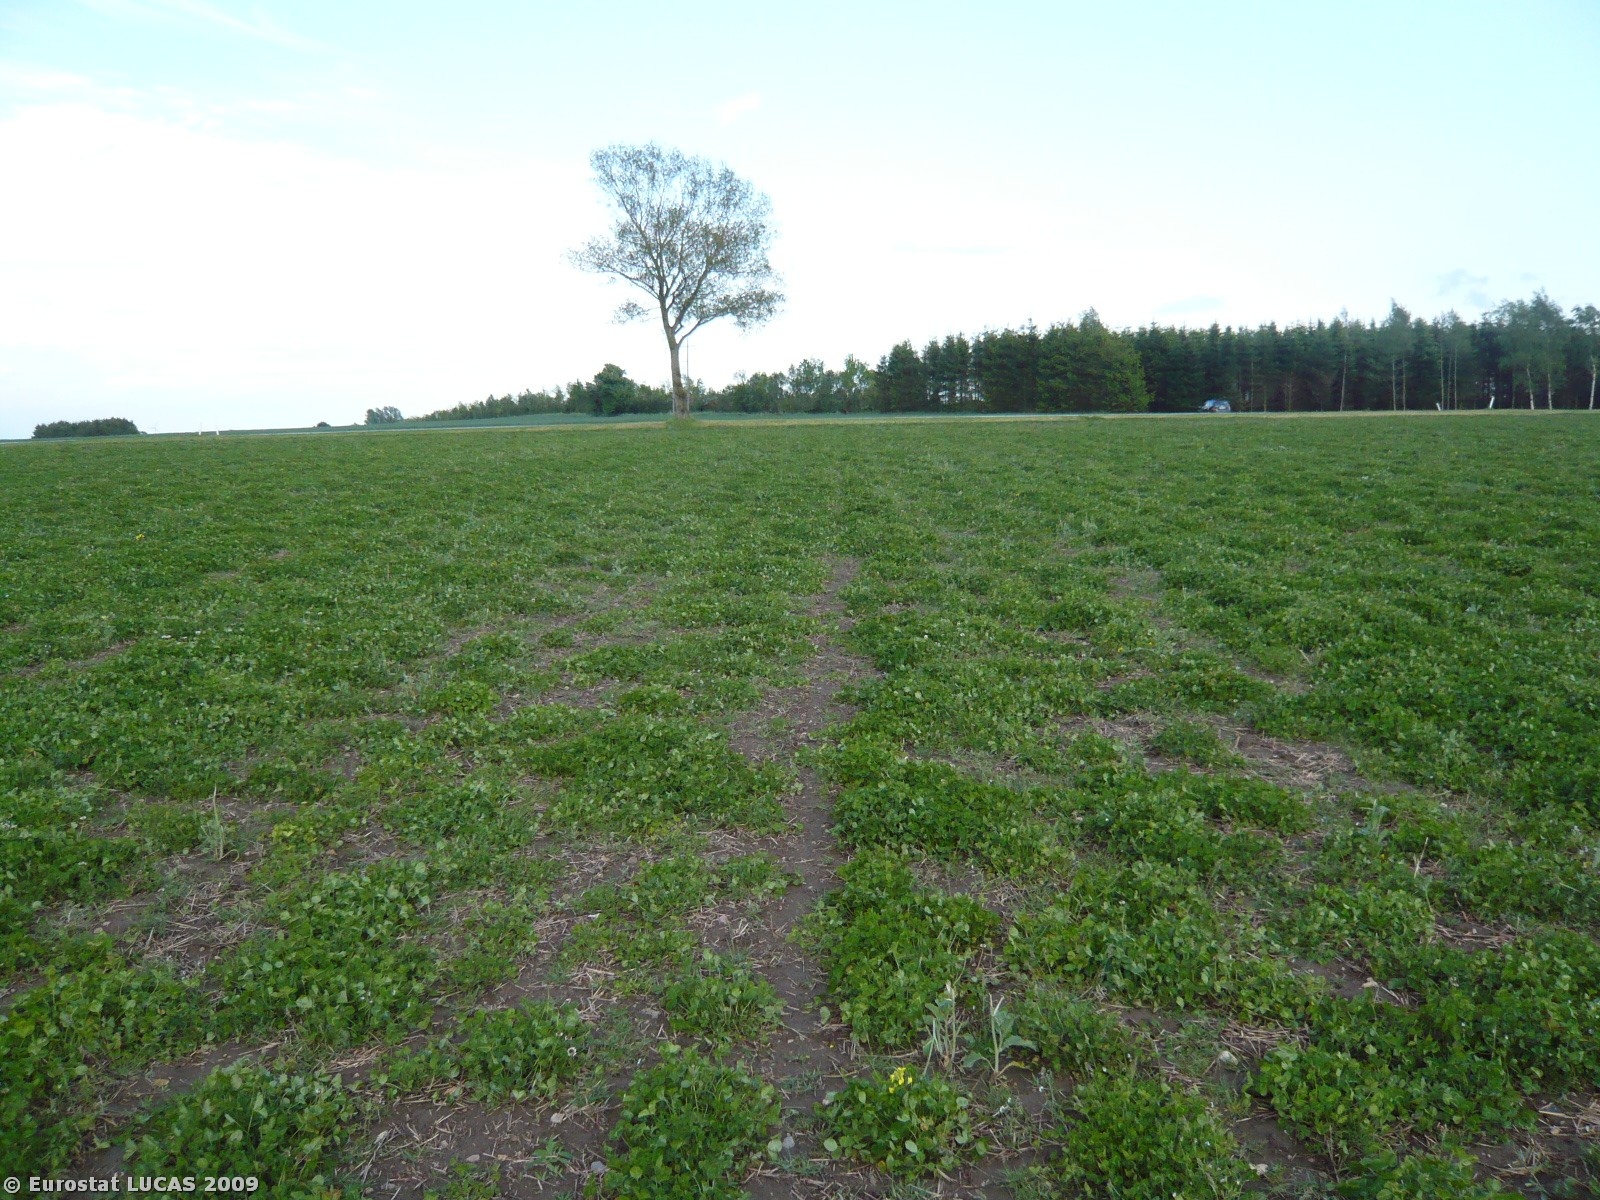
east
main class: Cropland
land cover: Clovers
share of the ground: > 75 %
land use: Agriculture (excluding fallow land and kitchen gardens)
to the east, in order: Clovers; Single bushes/trees; Grass margins; Paved roads, cycling and walking lanes; Grass margins; Common wheat; Electric lines; Common wheat; Single bushes/trees
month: May
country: DK
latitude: 55.4023
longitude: 11.7830
